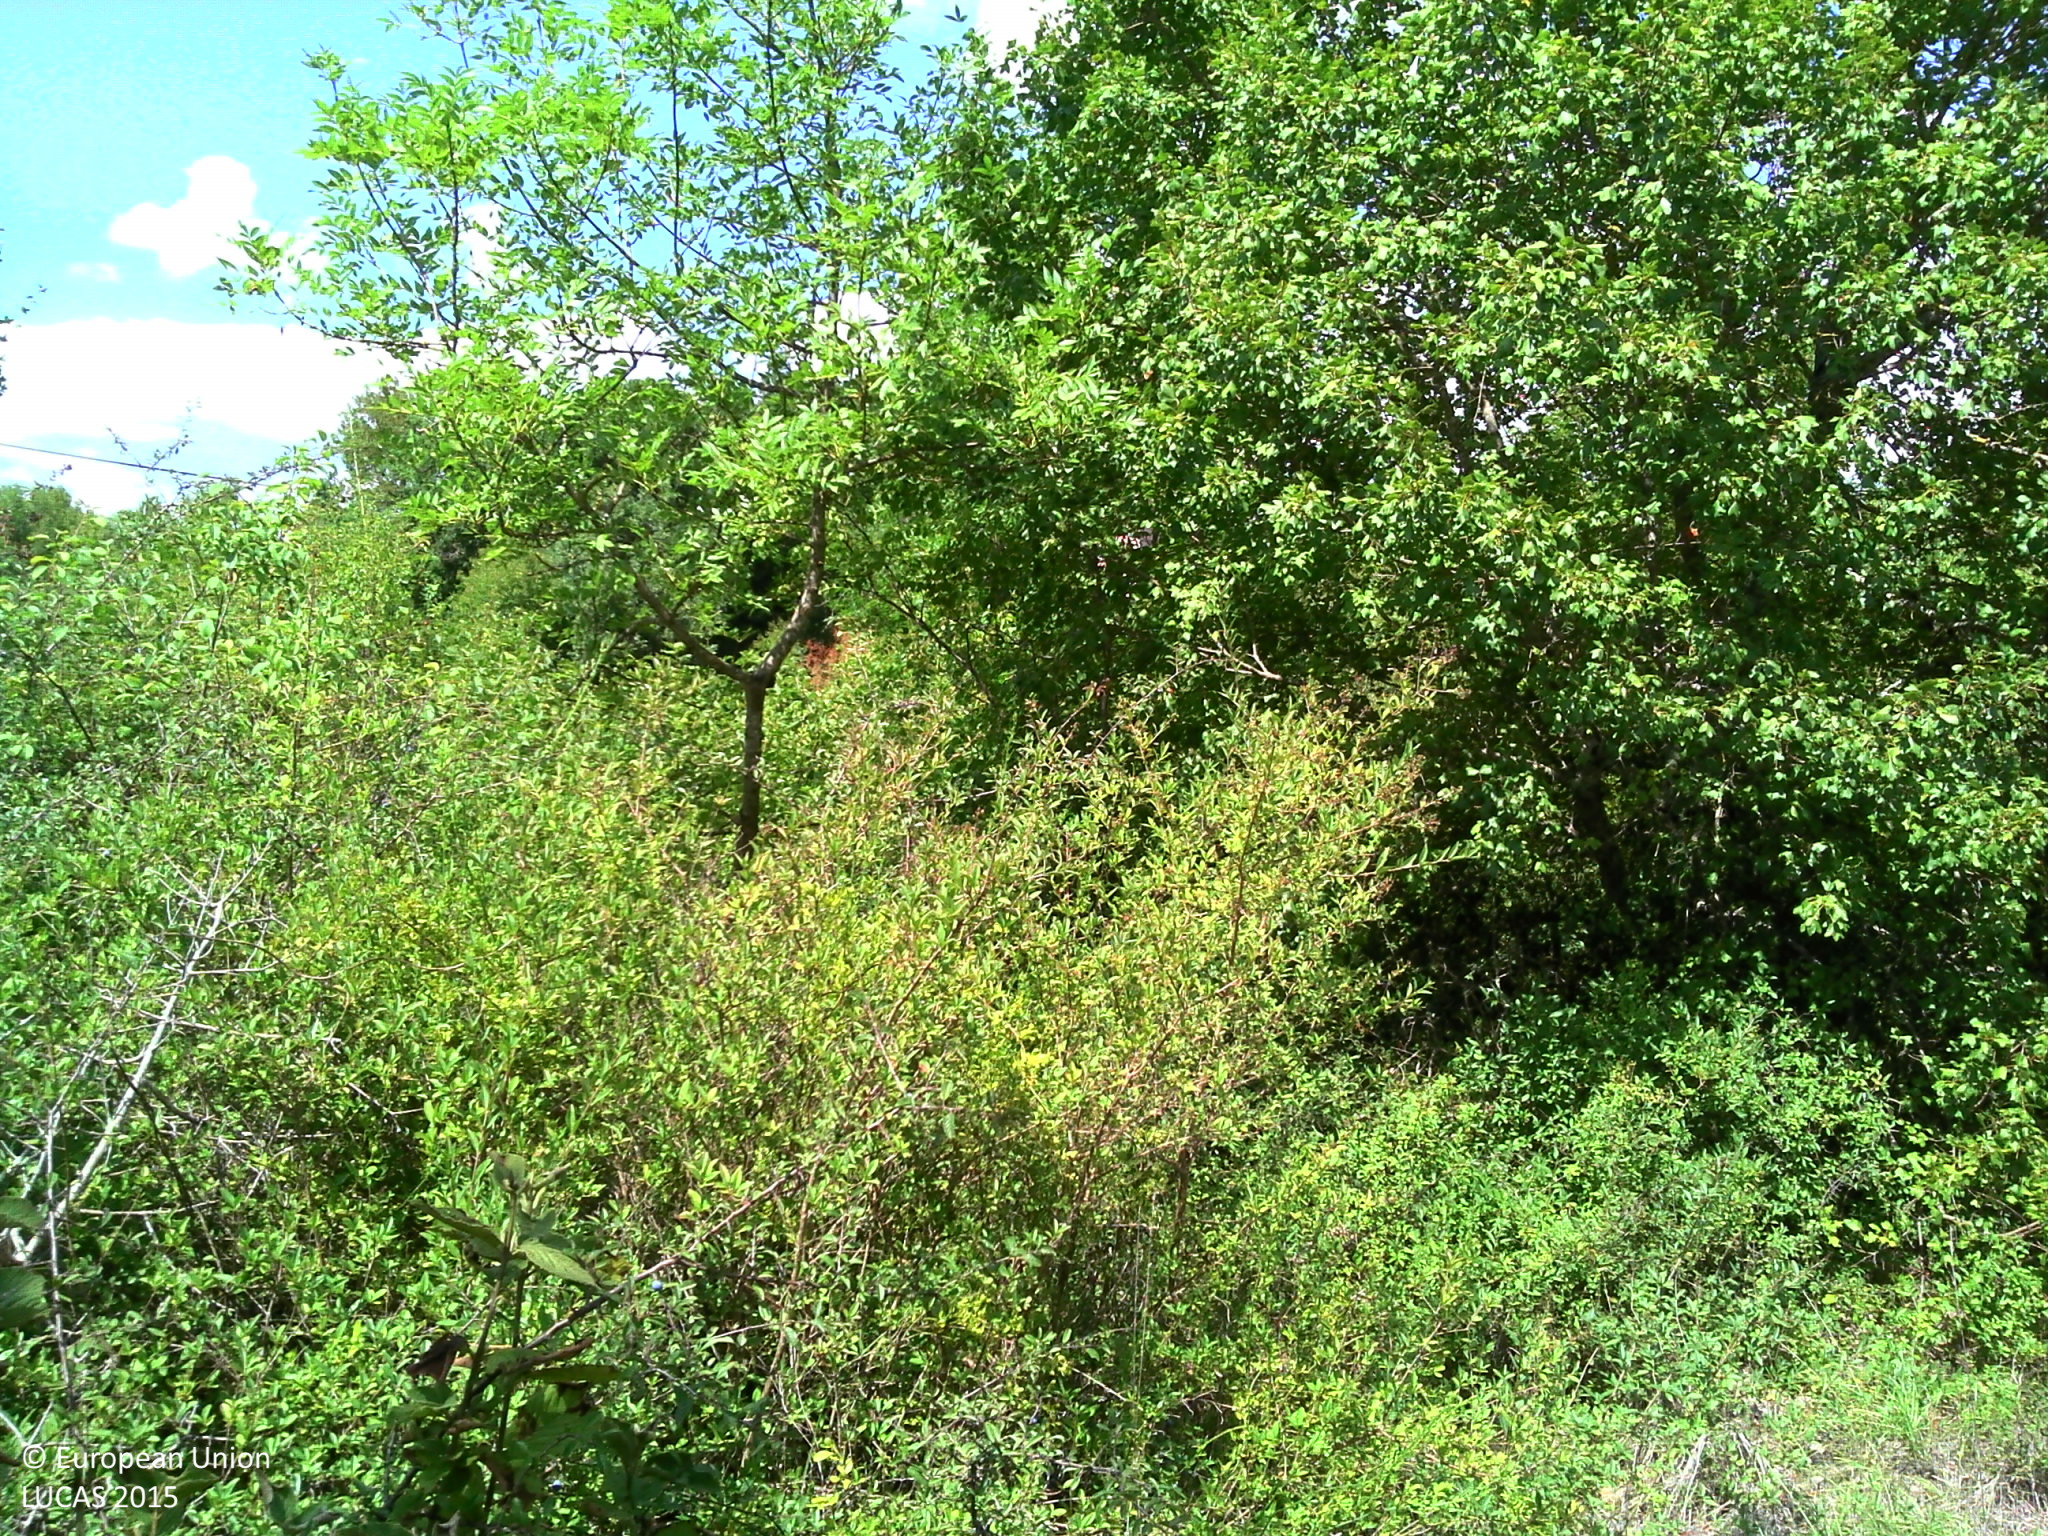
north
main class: Shrubland
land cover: Shrubland with sparse tree cover
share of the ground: > 75 %
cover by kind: shrubs 50 %, herbaceous plants 45 %, broadleaved forest trees 5 %
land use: Semi-natural and natural areas not in use
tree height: < 5 m
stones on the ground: < 10 %
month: August
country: FR
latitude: 44.1236
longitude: 1.6655
